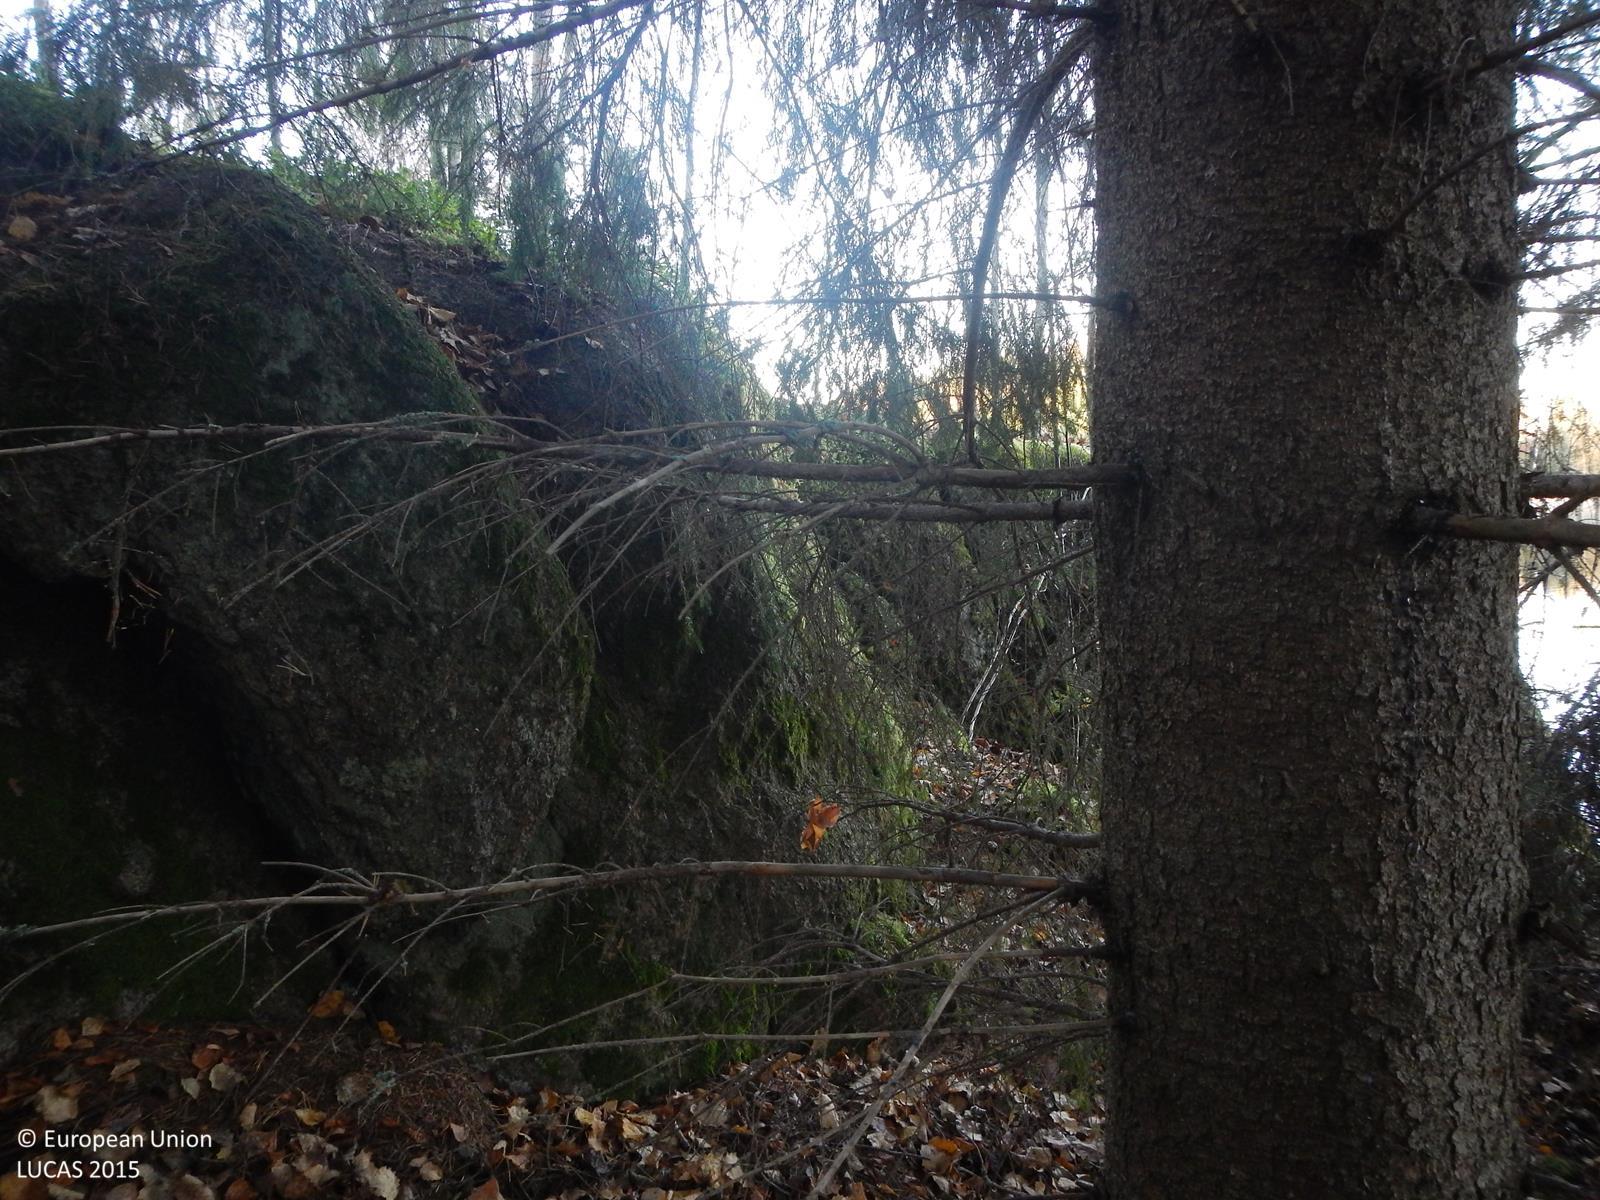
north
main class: Woodland
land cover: Spruce dominated coniferous woodland
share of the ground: > 75 %
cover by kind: coniferous forest trees 90 %, lichens and mosses 5 %, unconsolidated bare surface 5 %
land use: Forestry
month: October
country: FI
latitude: 61.7056
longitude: 25.8822
